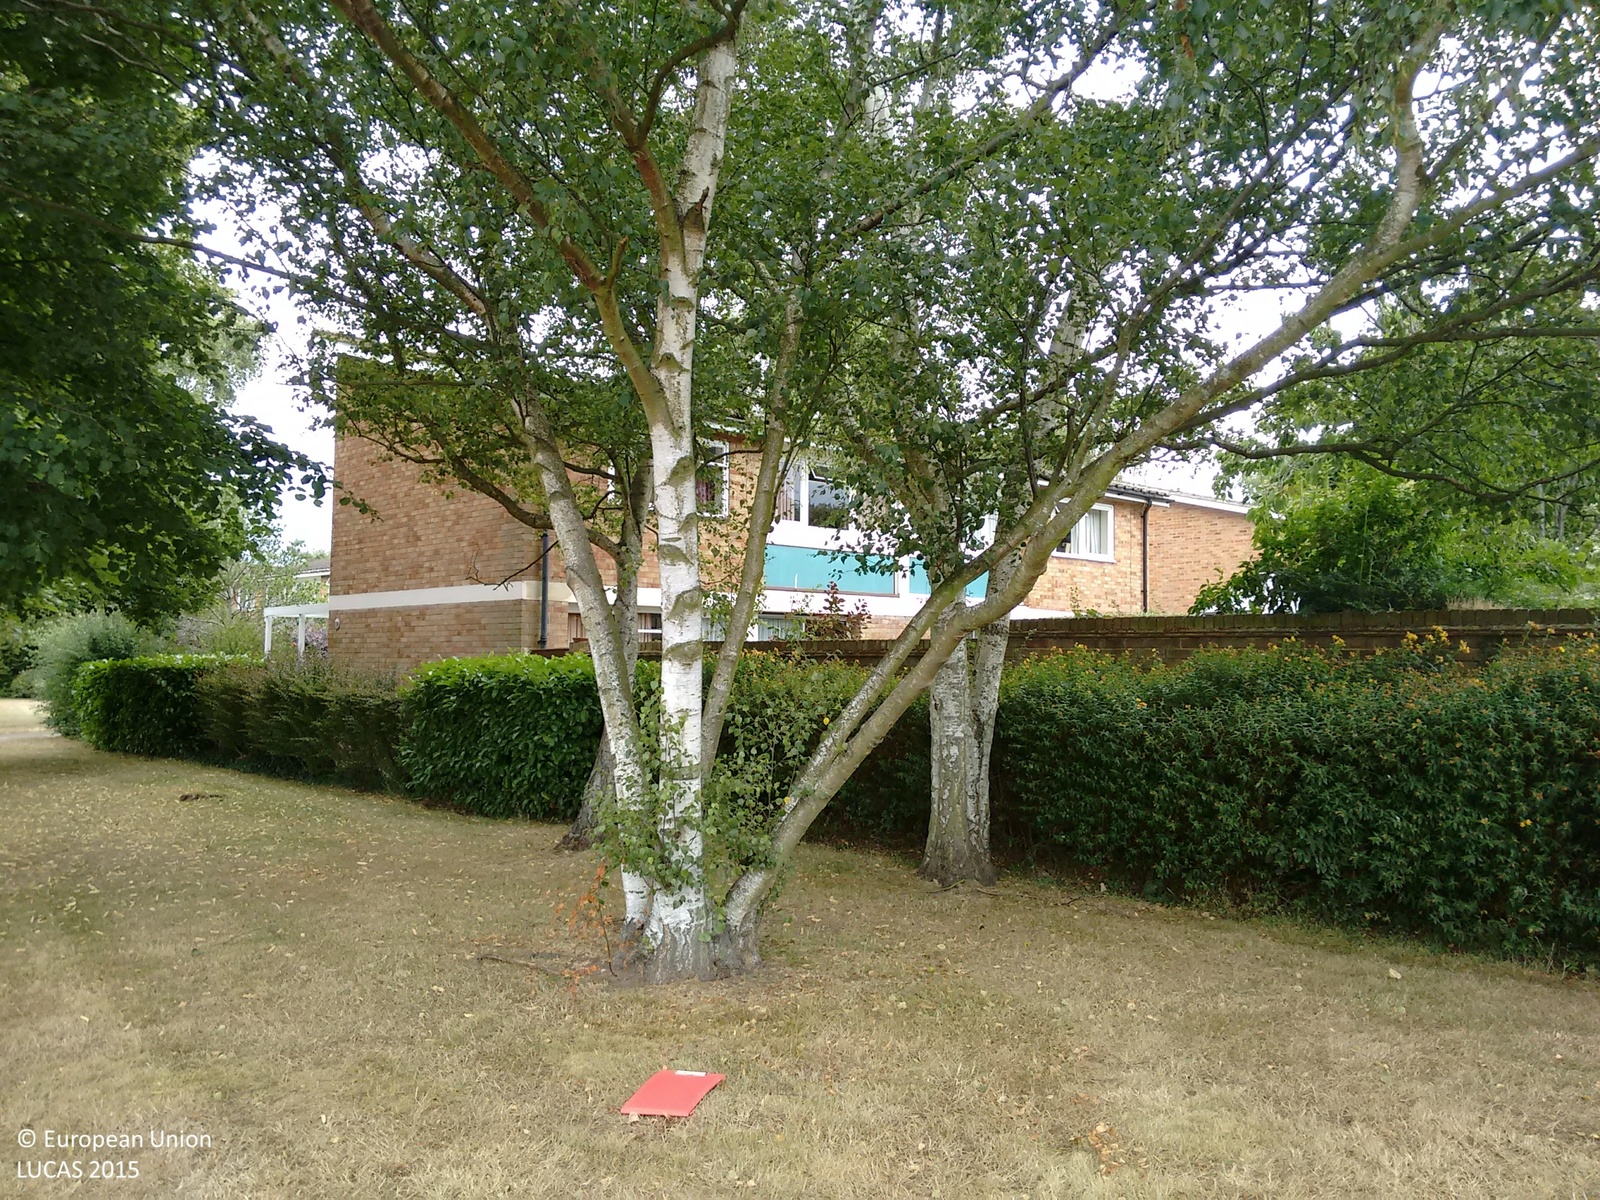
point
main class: Woodland
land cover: Broadleaved woodland
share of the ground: > 75 %
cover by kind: broadleaved forest trees 50 %, herbaceous plants 50 %
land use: Residential
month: July
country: GB
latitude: 51.4368
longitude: -0.3220
